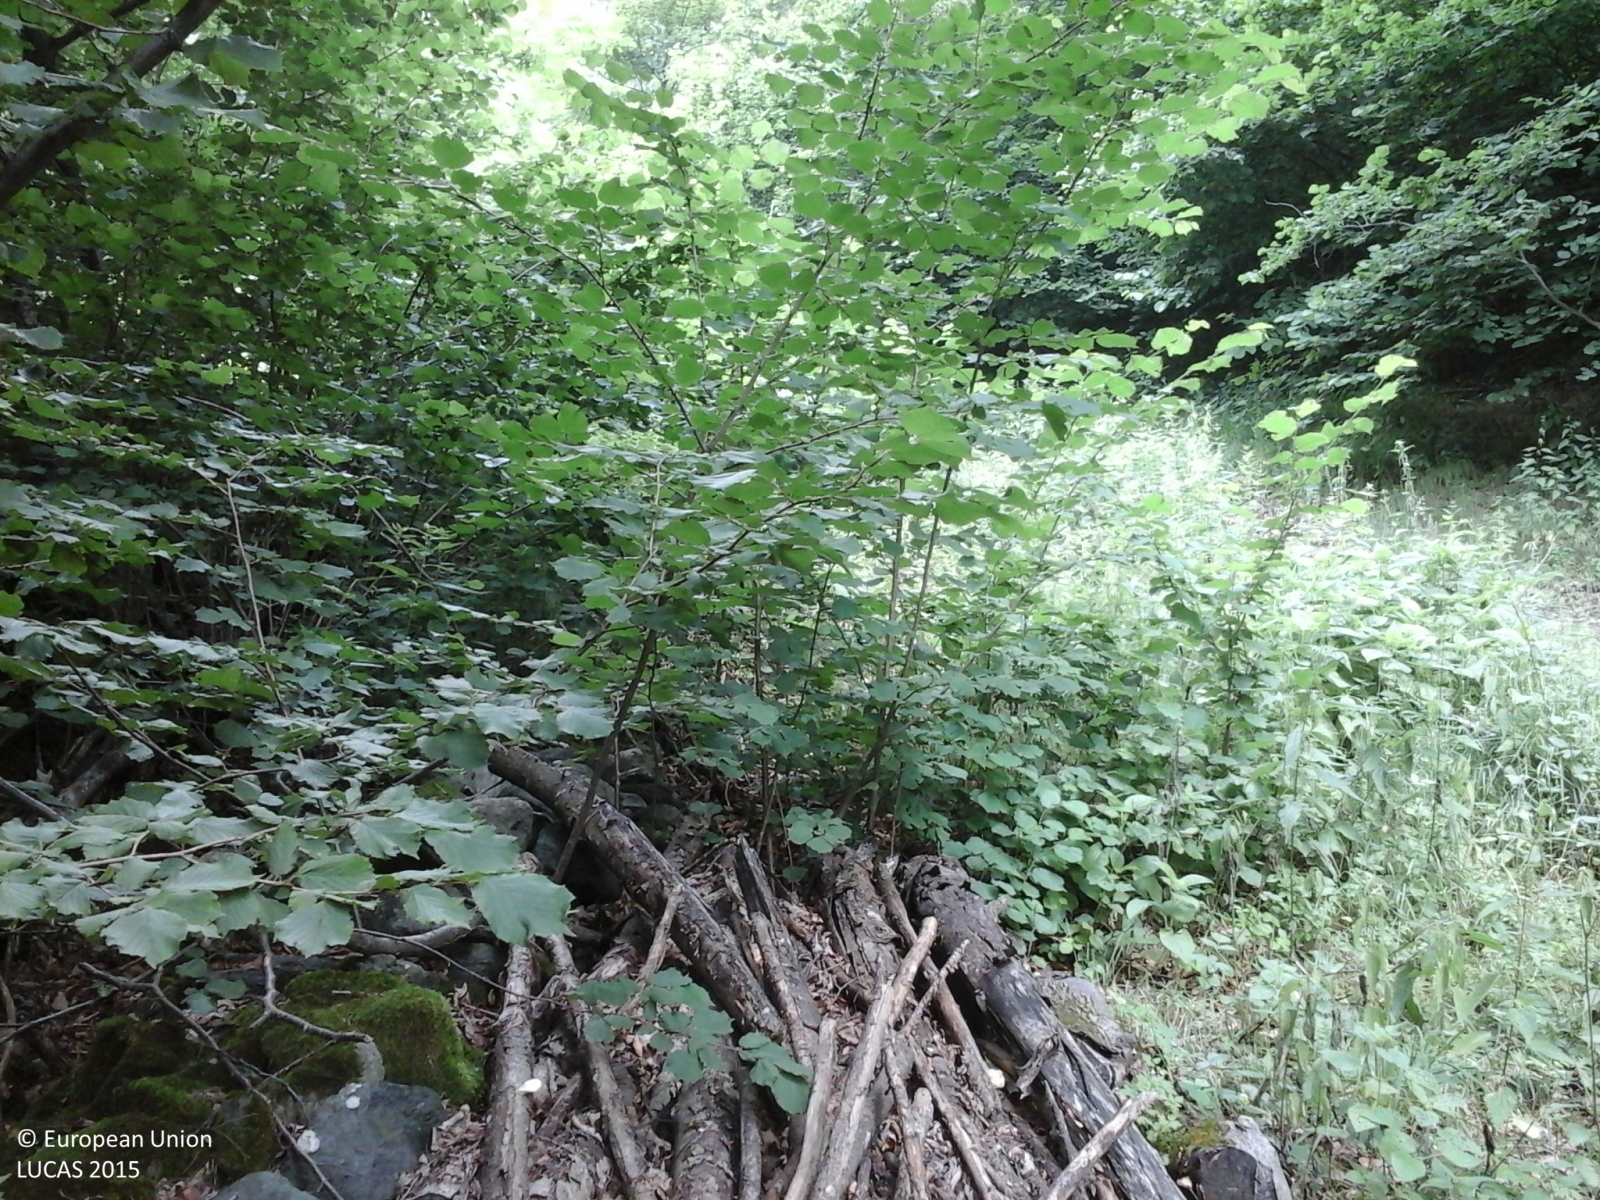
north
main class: Woodland
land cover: Broadleaved woodland
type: beech forest
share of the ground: > 75 %
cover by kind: broadleaved forest trees 100 %
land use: Forestry
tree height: > 5 m
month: July
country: IT
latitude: 45.2339
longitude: 7.2403
